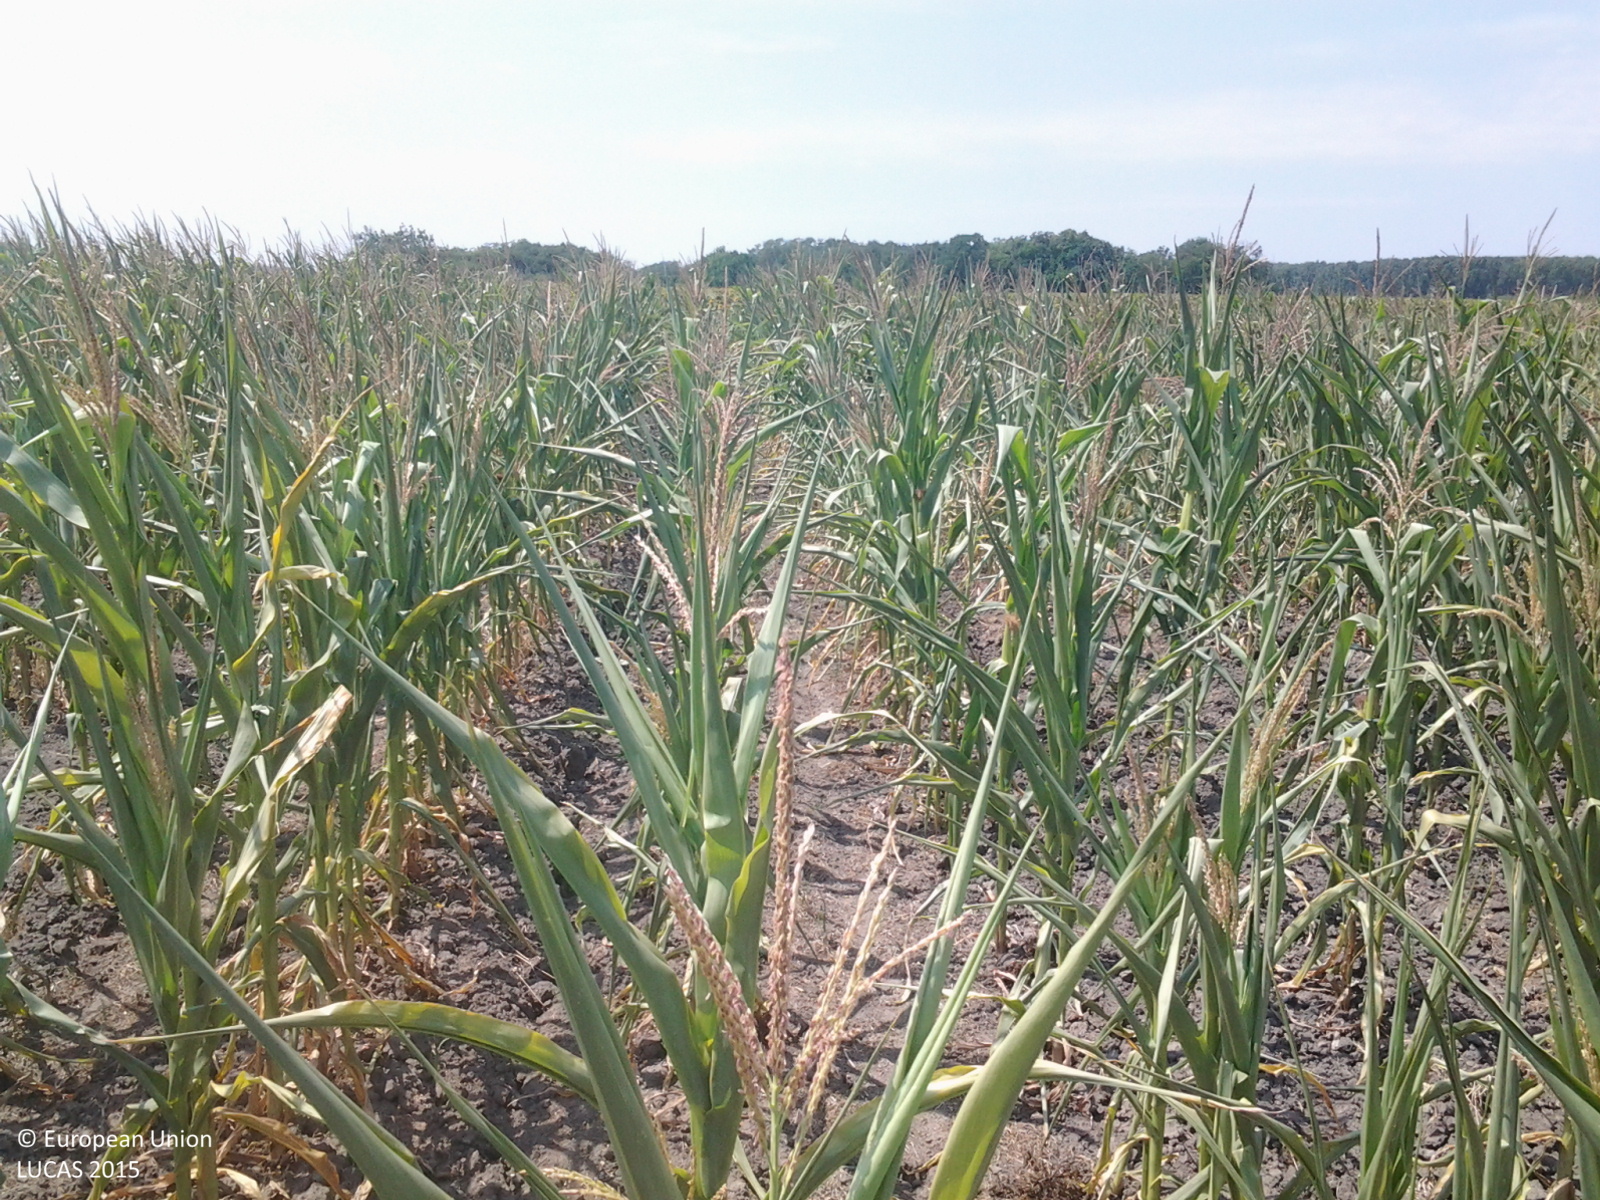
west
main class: Cropland
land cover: Maize
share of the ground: > 75 %
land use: Agriculture (excluding fallow land and kitchen gardens)
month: July
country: HU
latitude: 46.8216
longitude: 21.4822
